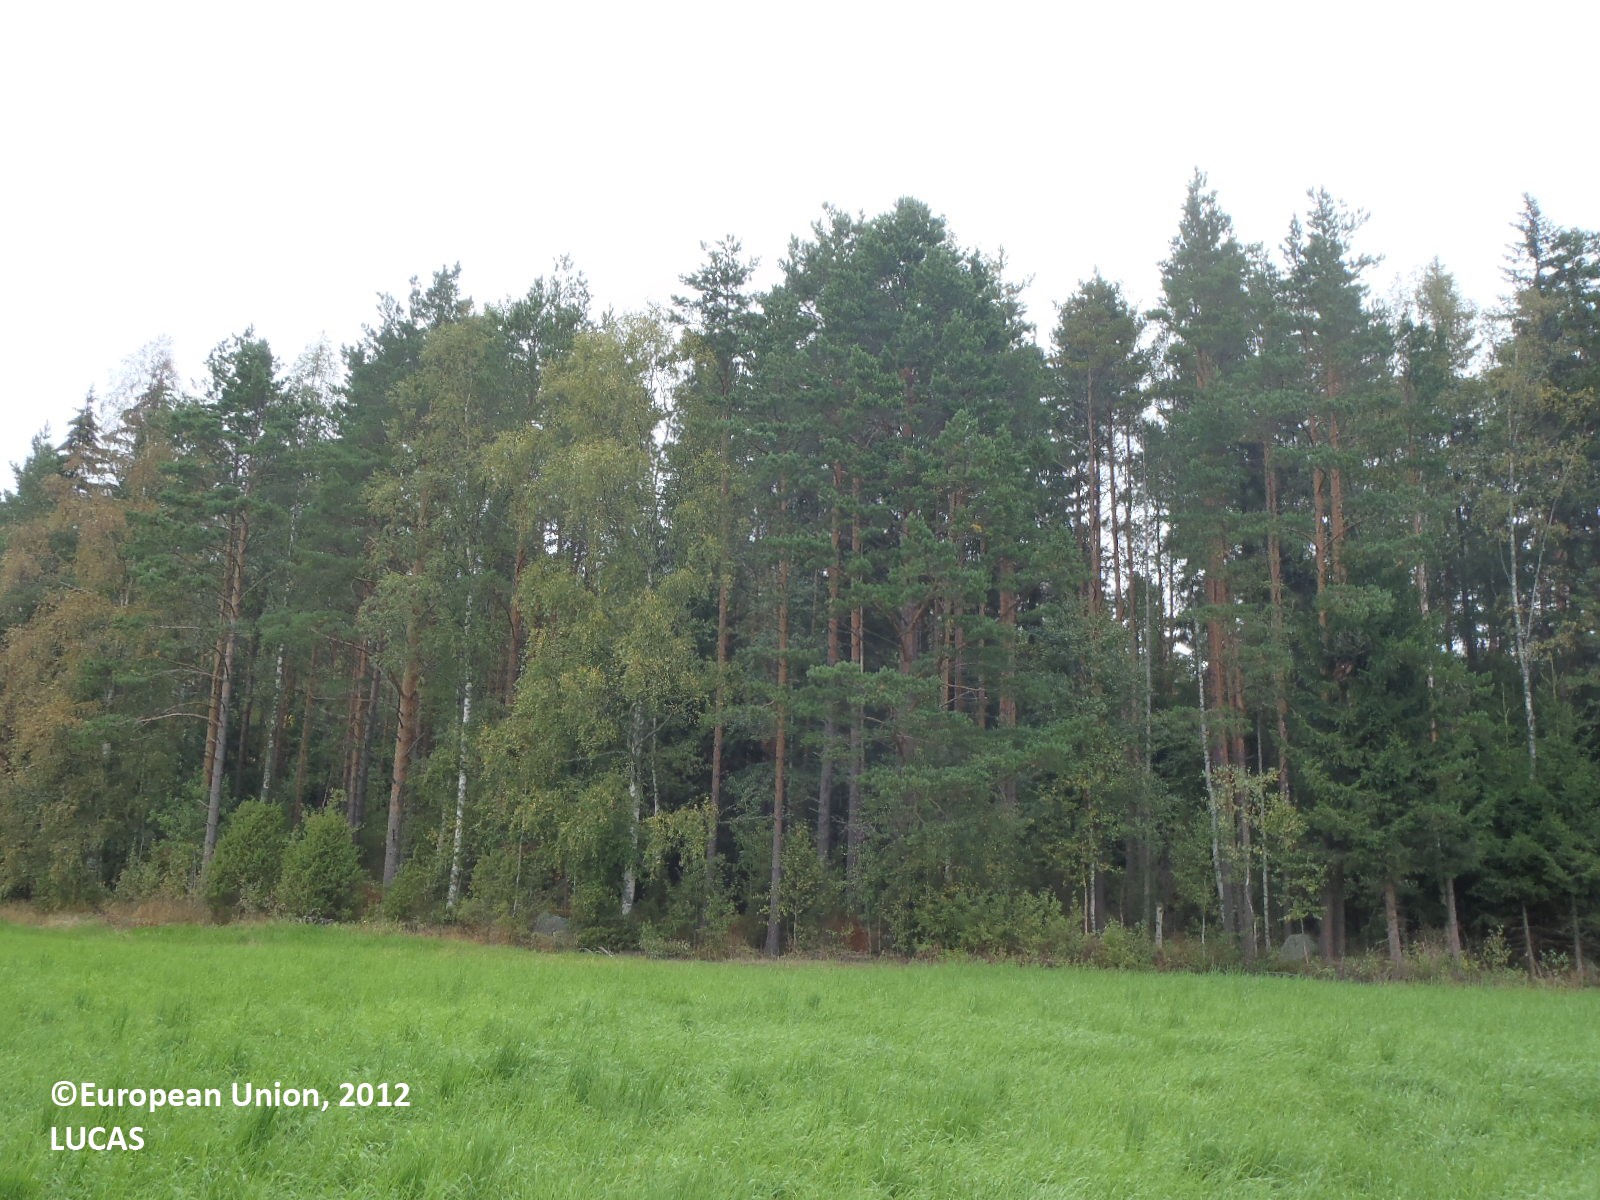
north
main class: Cropland
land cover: Temporary grasslands
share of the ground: > 75 %
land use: Agriculture (excluding fallow land and kitchen gardens)
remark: Harvested field
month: August
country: FI
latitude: 60.8046
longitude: 21.9139
